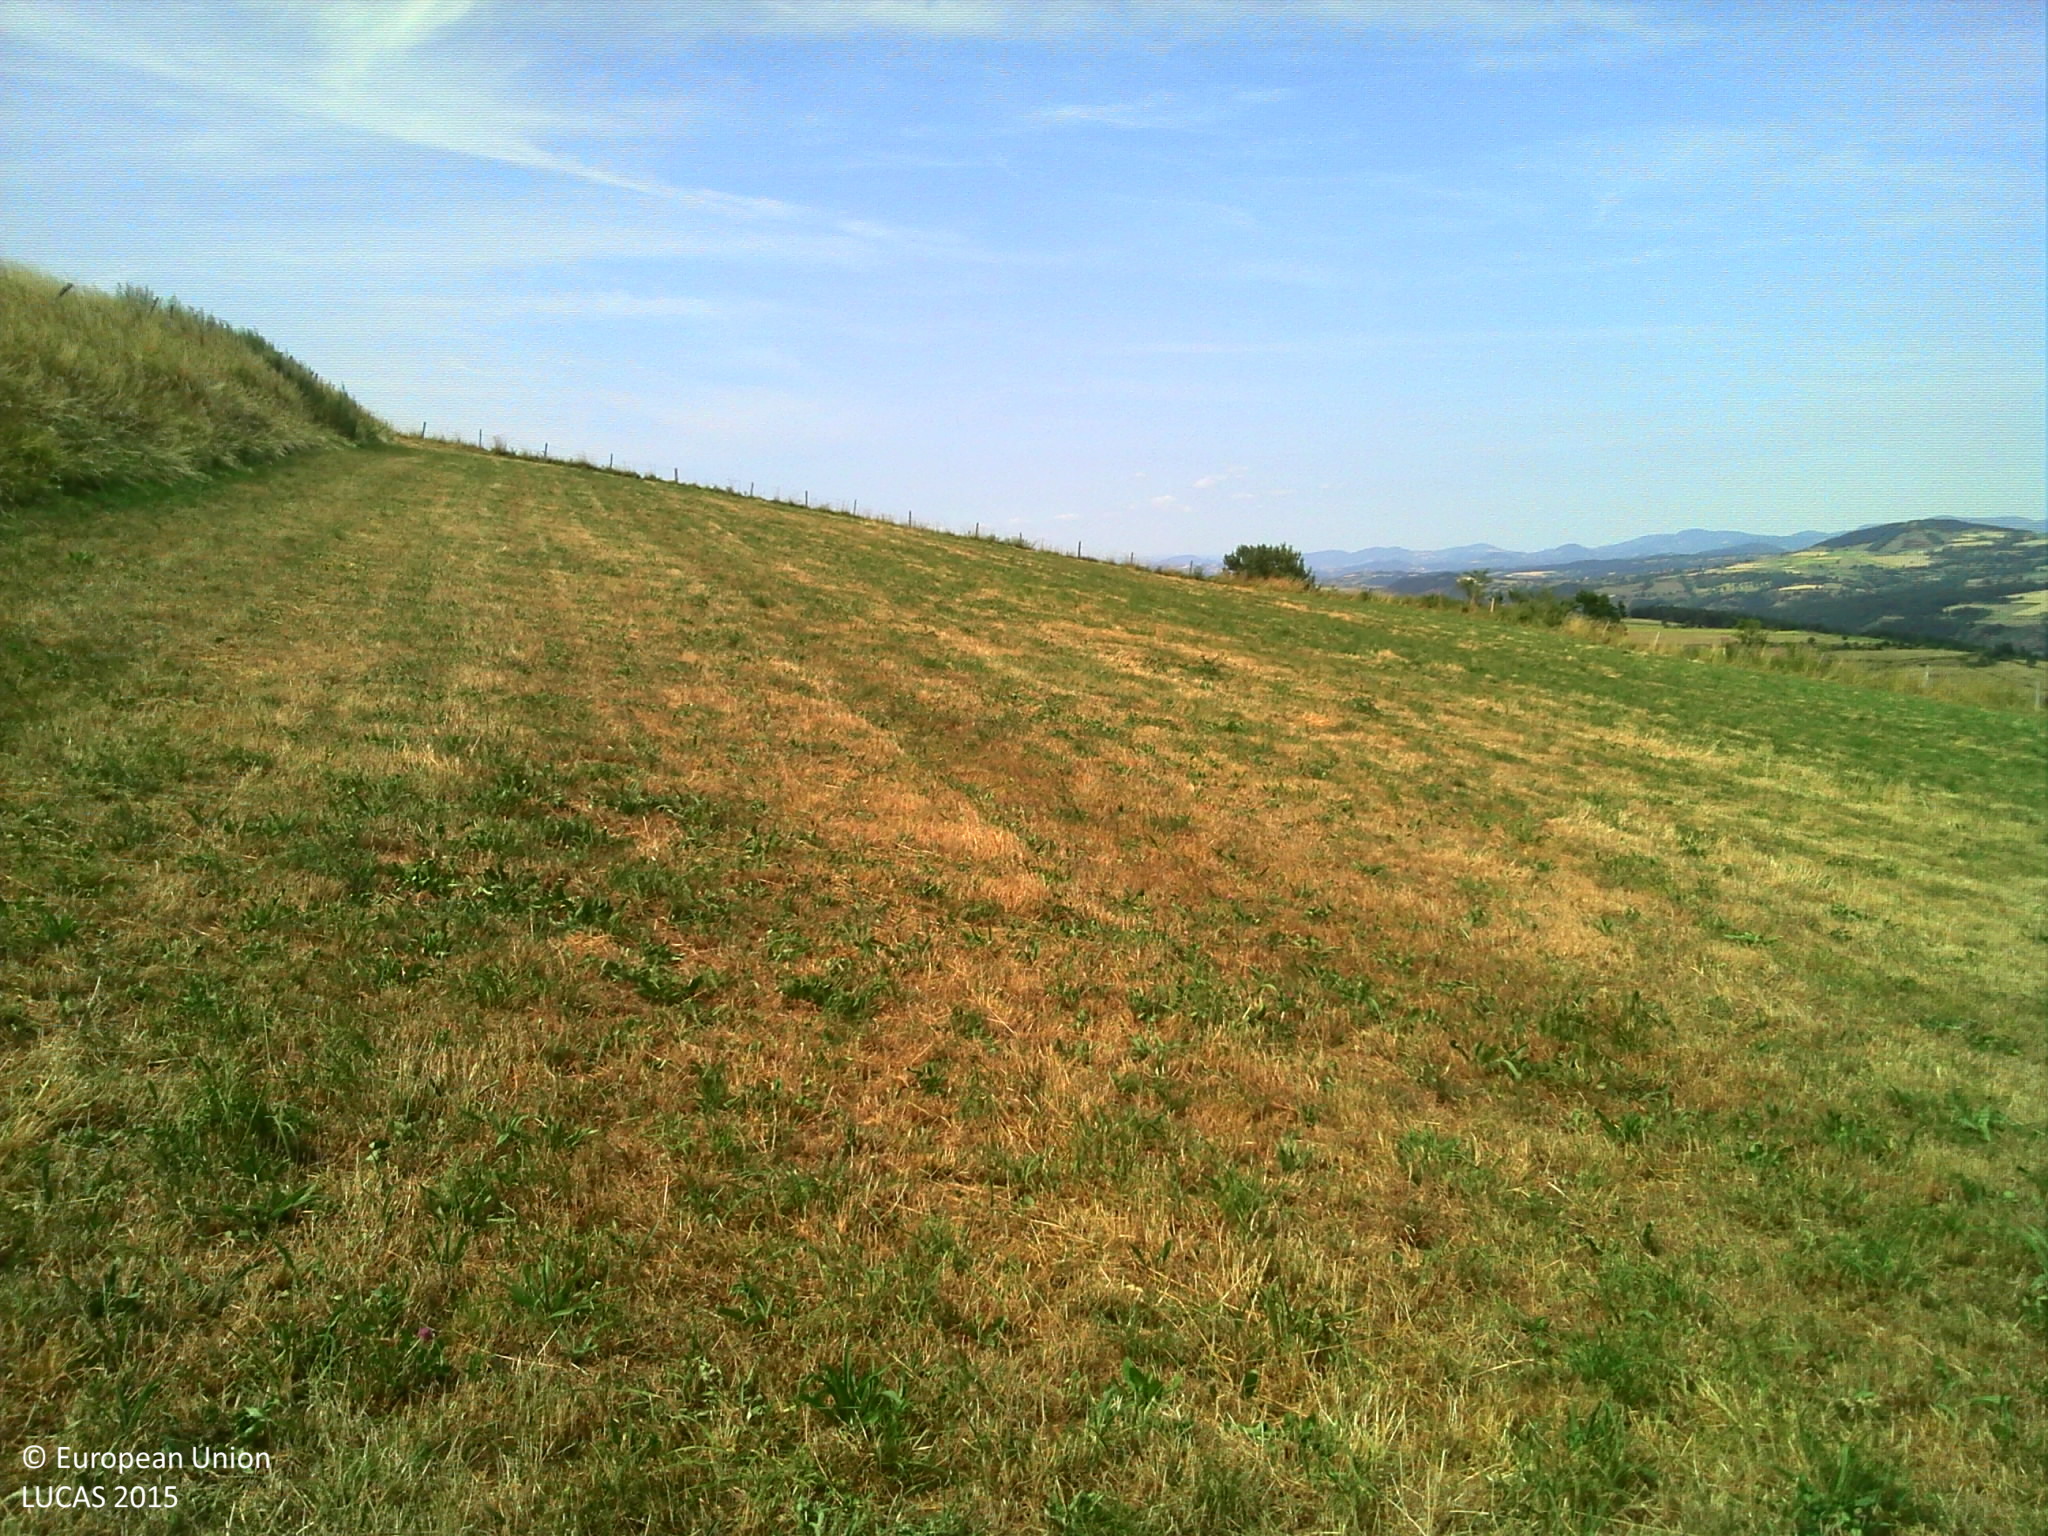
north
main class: Grassland
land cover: Grassland without tree/shrub cover
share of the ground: > 75 %
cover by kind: herbaceous plants 100 %
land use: Agriculture (excluding fallow land and kitchen gardens)
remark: Harvested field
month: July
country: FR
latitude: 44.8397
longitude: 3.8946
